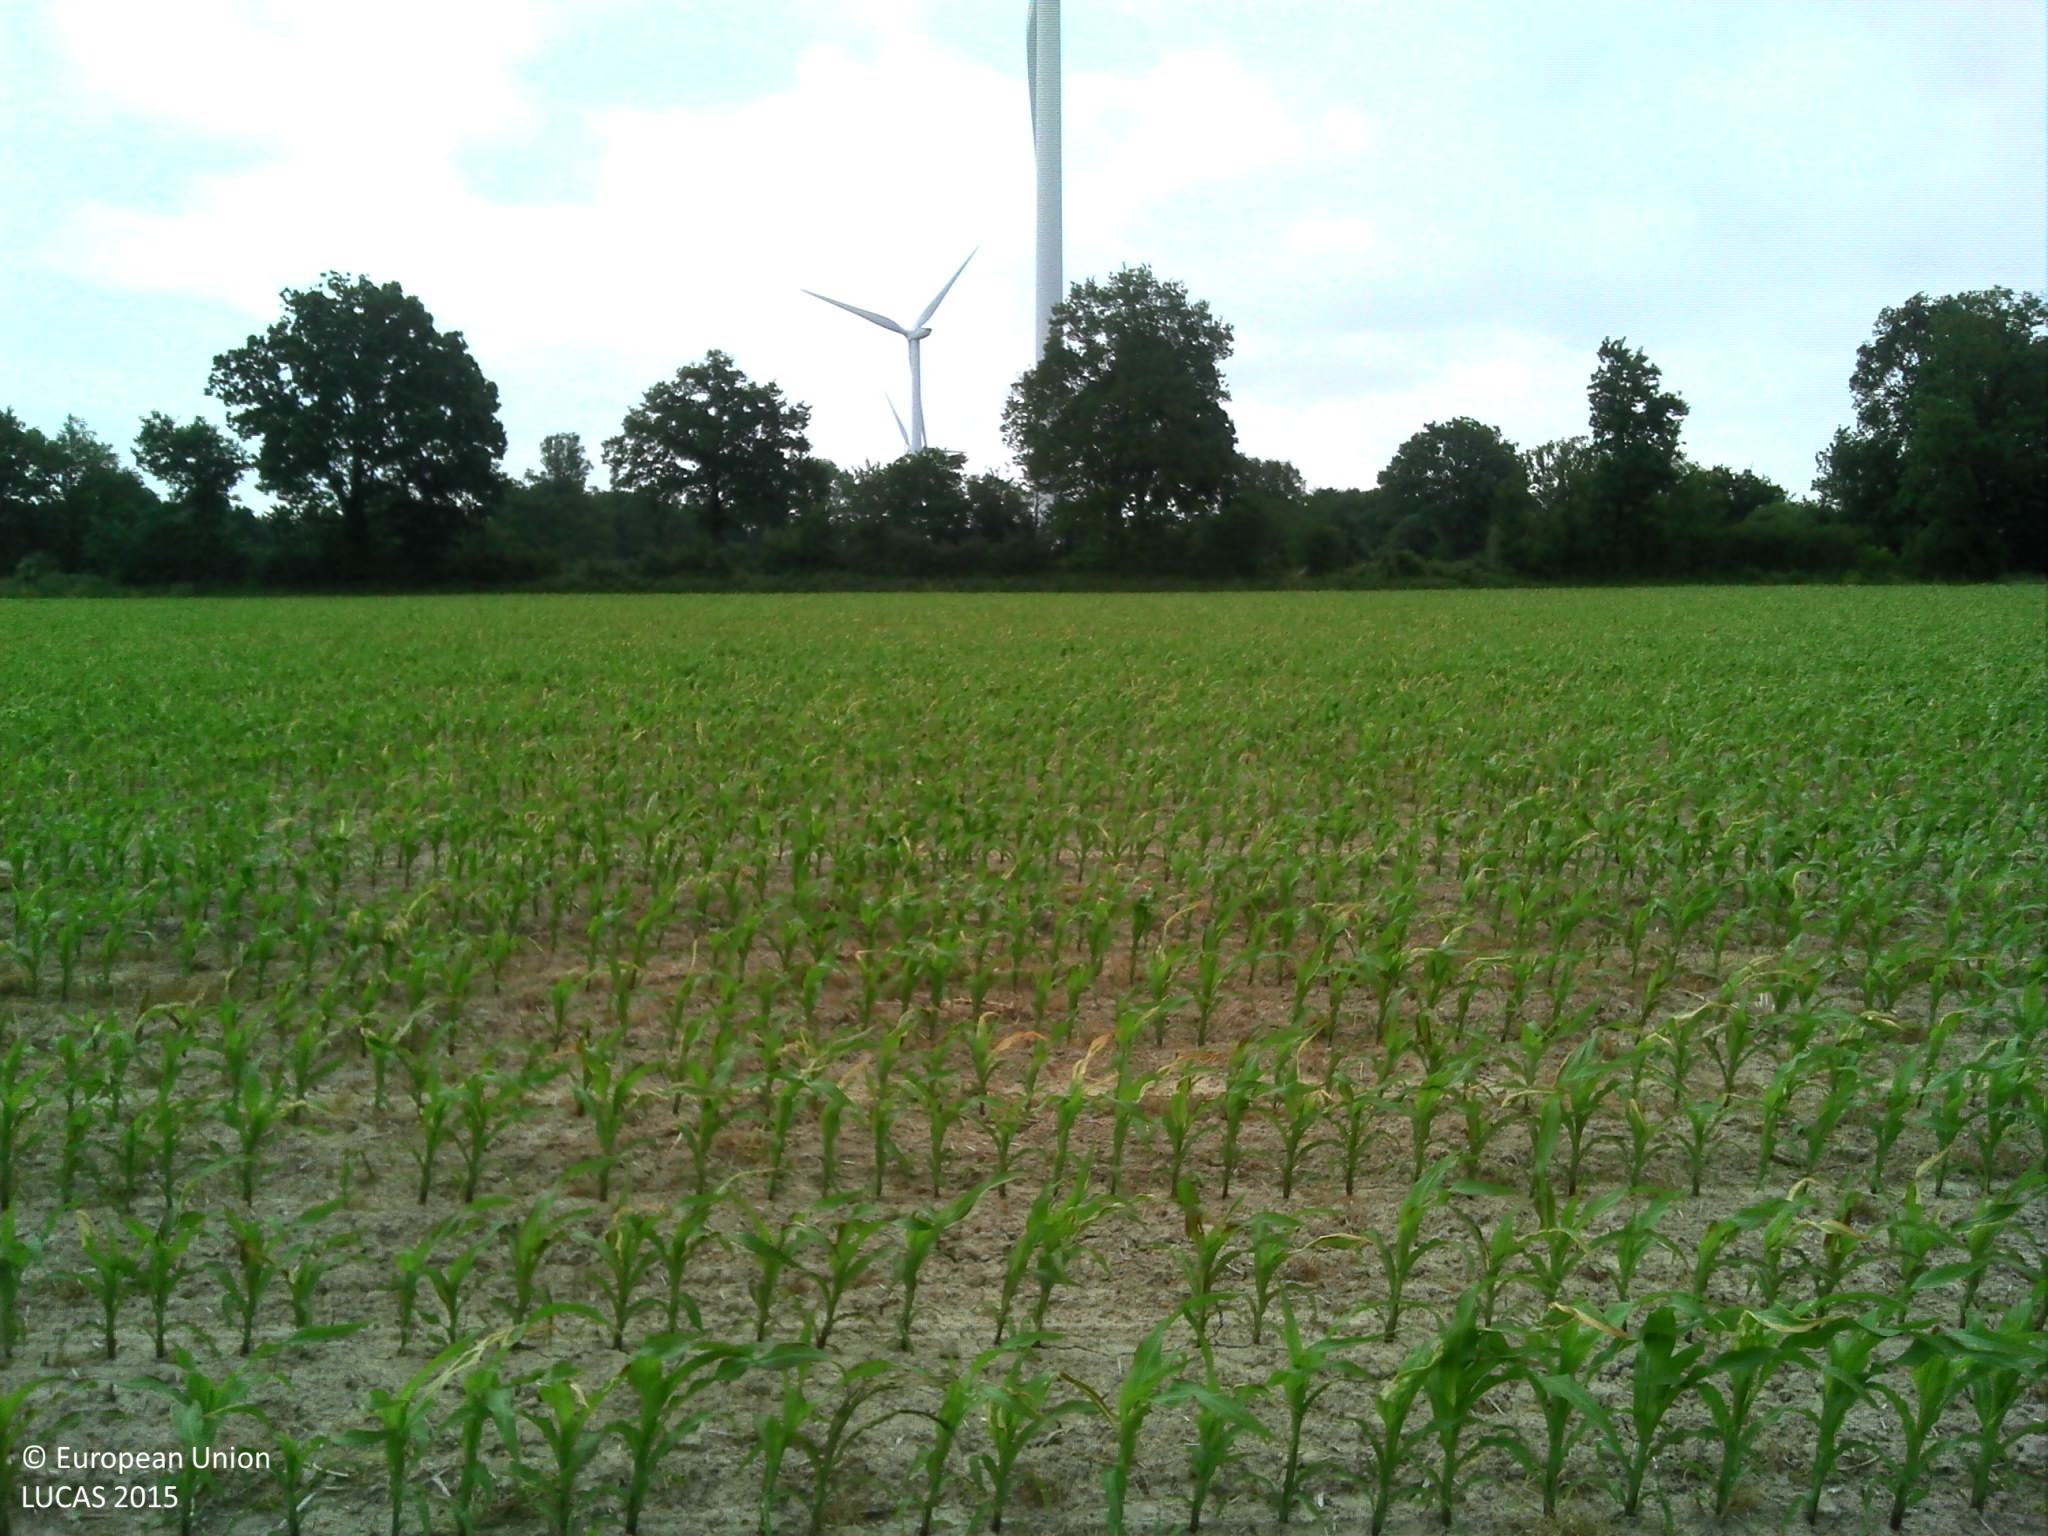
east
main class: Cropland
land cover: Maize
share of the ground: 25 - 50 %
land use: Agriculture (excluding fallow land and kitchen gardens)
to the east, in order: Maize; Grass margins; Managed hedges; Ditches and canals; Grass margins; Tracks; Grass margins; Ditches and canals; Managed hedges; Fences; Maize
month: June
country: FR
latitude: 47.0020
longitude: -1.4954
